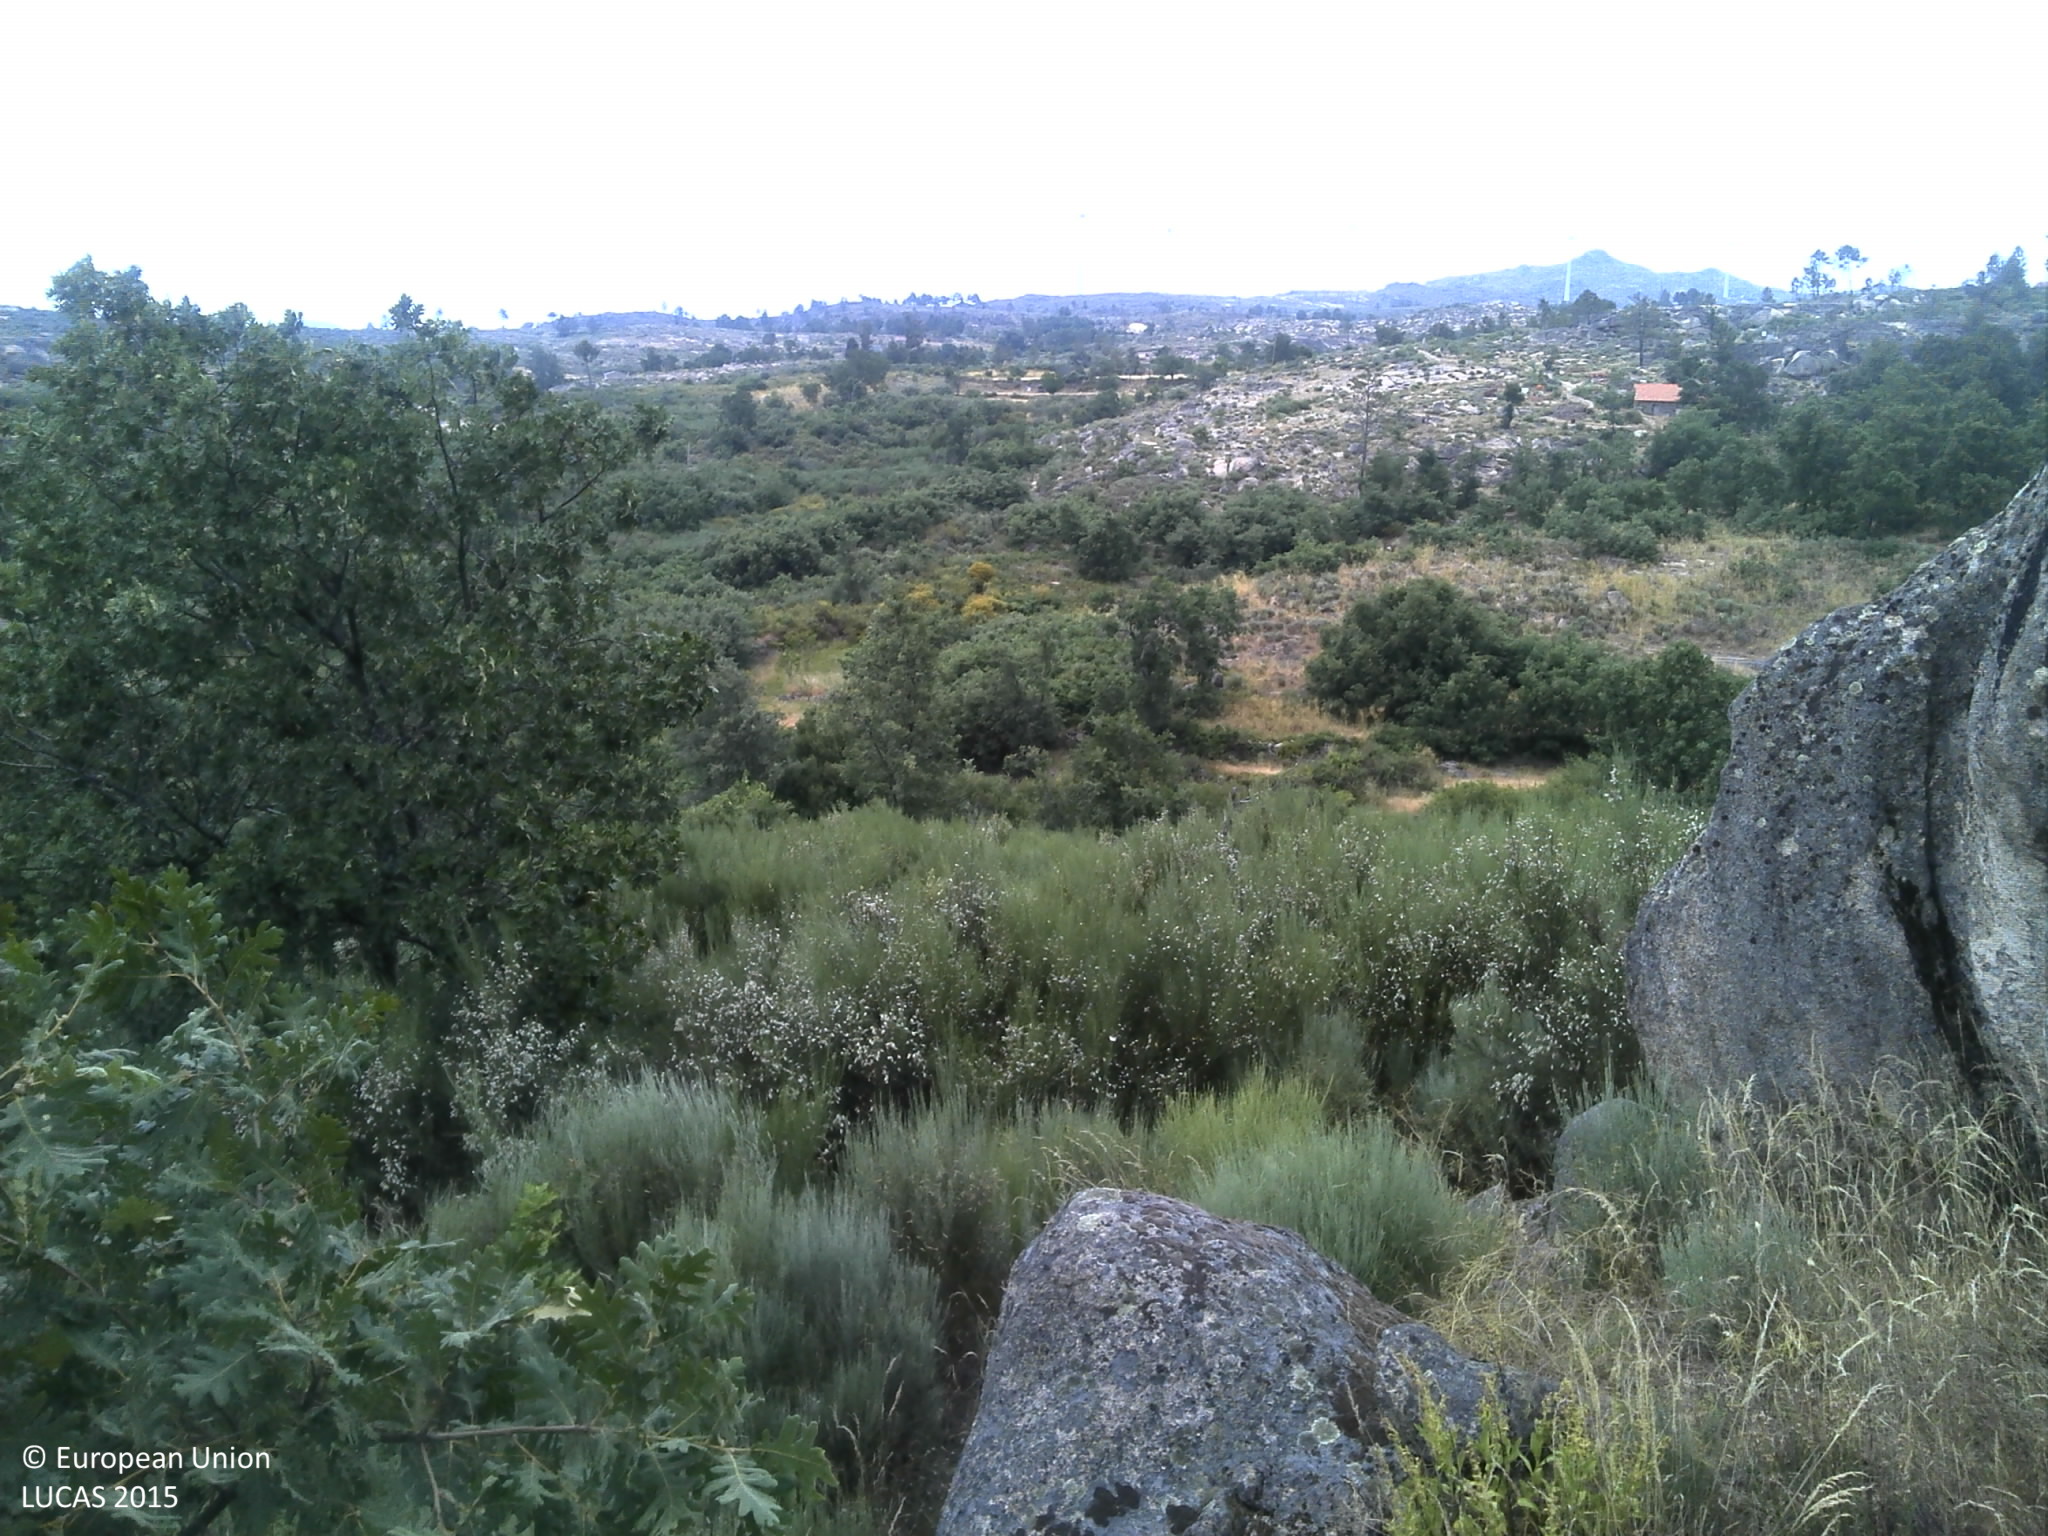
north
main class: Shrubland
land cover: Shrubland with sparse tree cover
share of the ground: 50 - 75 %
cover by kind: shrubs 60 %, herbaceous plants 15 %, consolidated bare surface 10 %, unconsolidated bare surface 10 %, broadleaved forest trees 5 %
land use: Abandoned areas
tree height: > 5 m
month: June
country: PT
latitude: 40.3216
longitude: -7.2005
